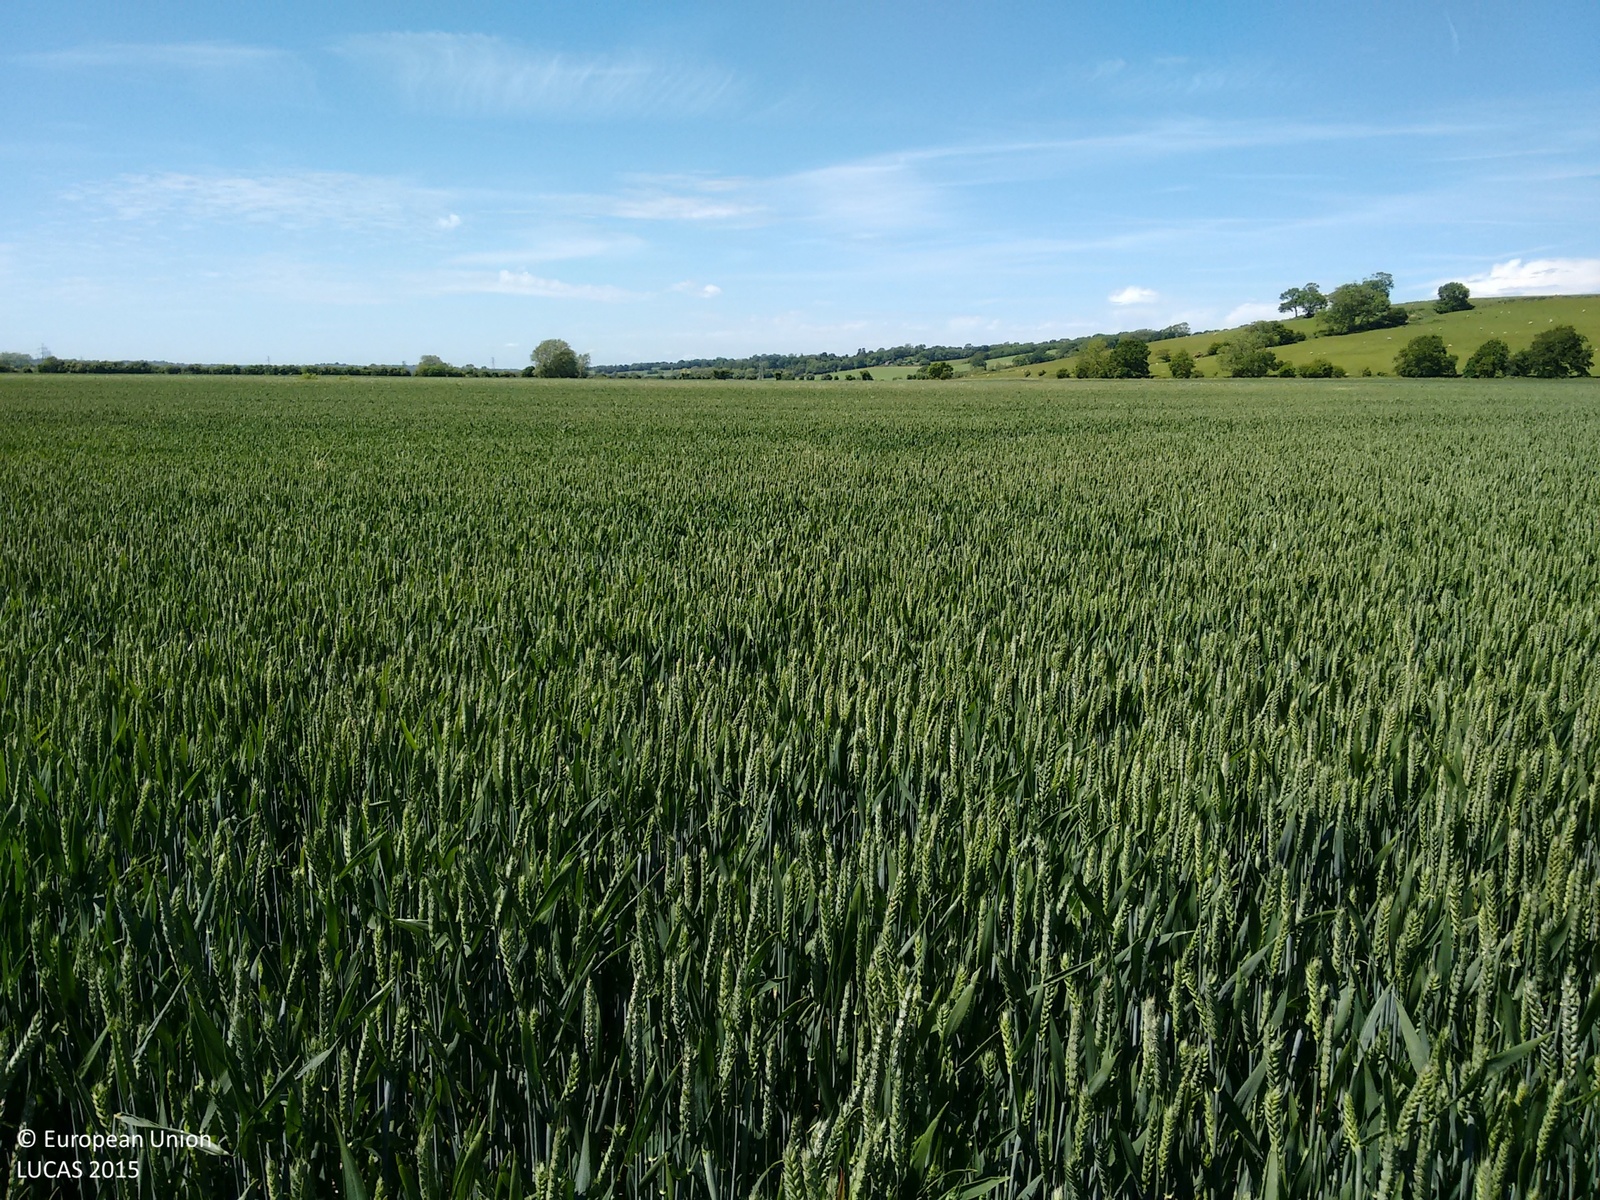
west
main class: Cropland
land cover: Common wheat
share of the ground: > 75 %
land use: Agriculture (excluding fallow land and kitchen gardens)
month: June
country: GB
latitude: 51.0025
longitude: 0.7544
